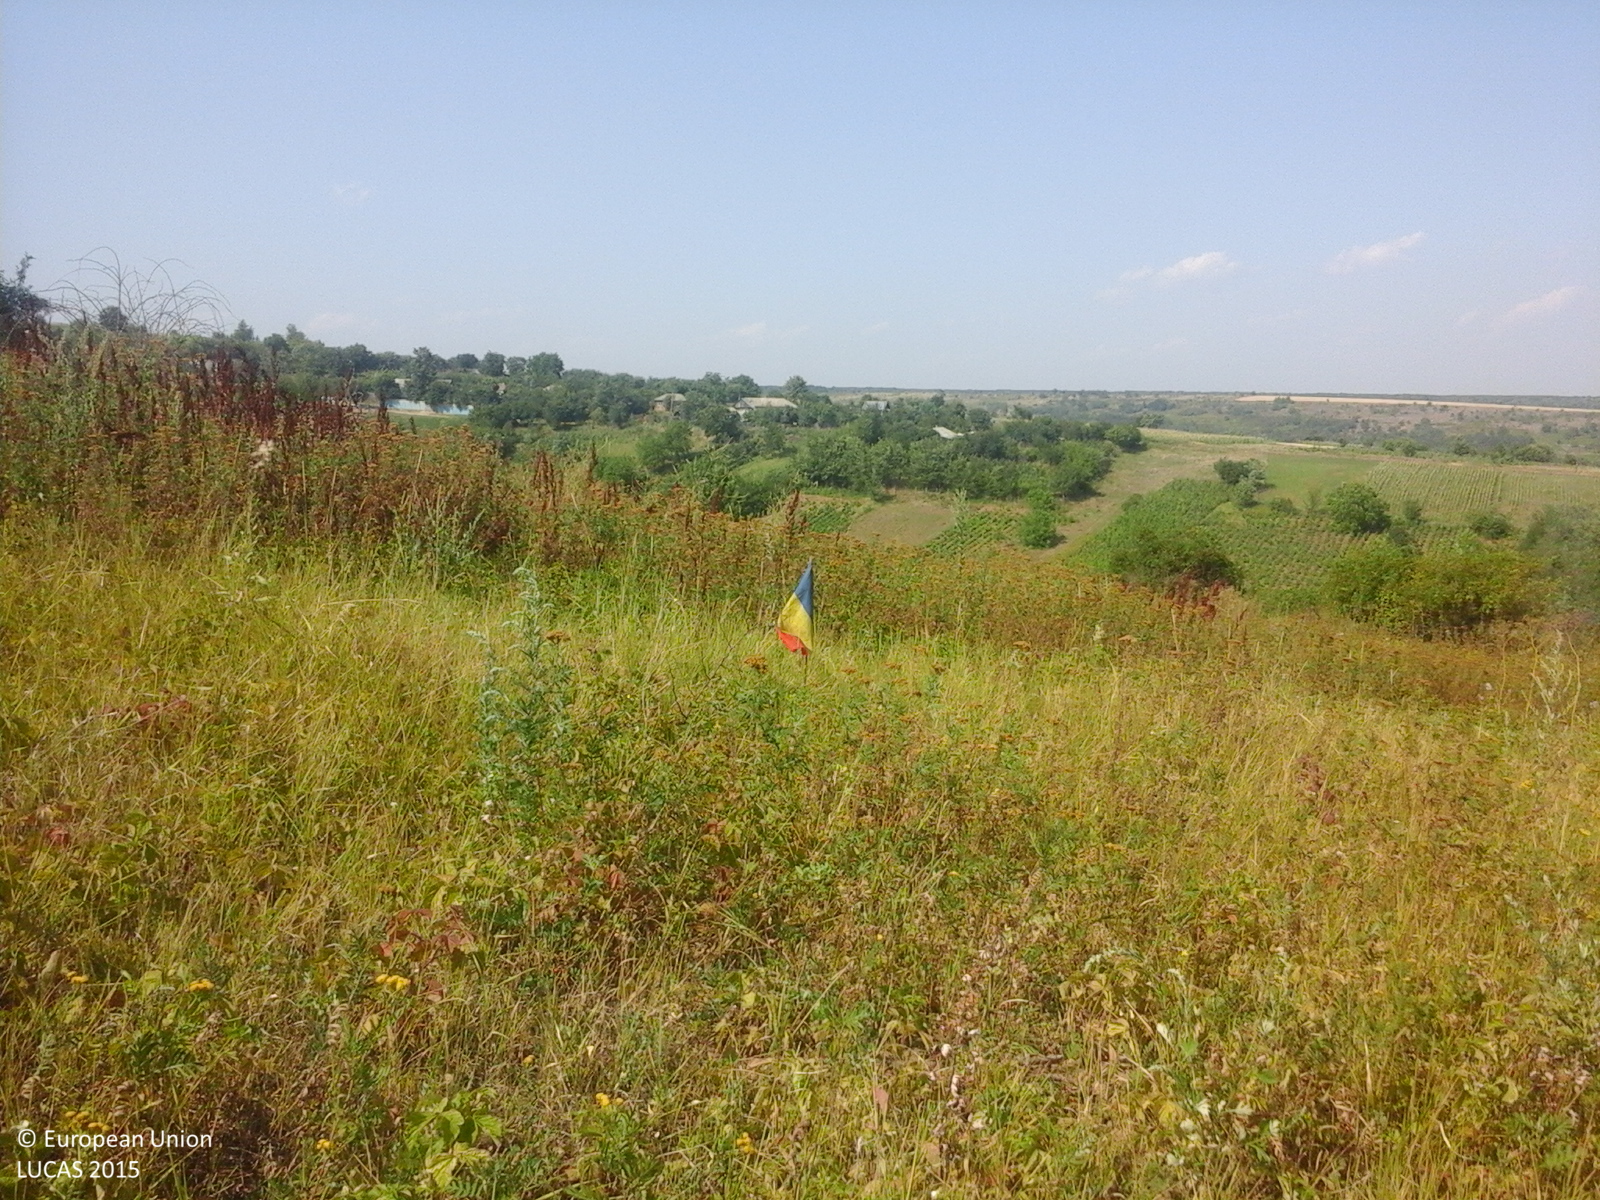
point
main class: Grassland
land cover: Spontaneously vegetated surfaces
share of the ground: > 75 %
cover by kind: herbaceous plants 100 %
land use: Agriculture (excluding fallow land and kitchen gardens)
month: July
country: RO
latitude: 46.2635
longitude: 27.3469
